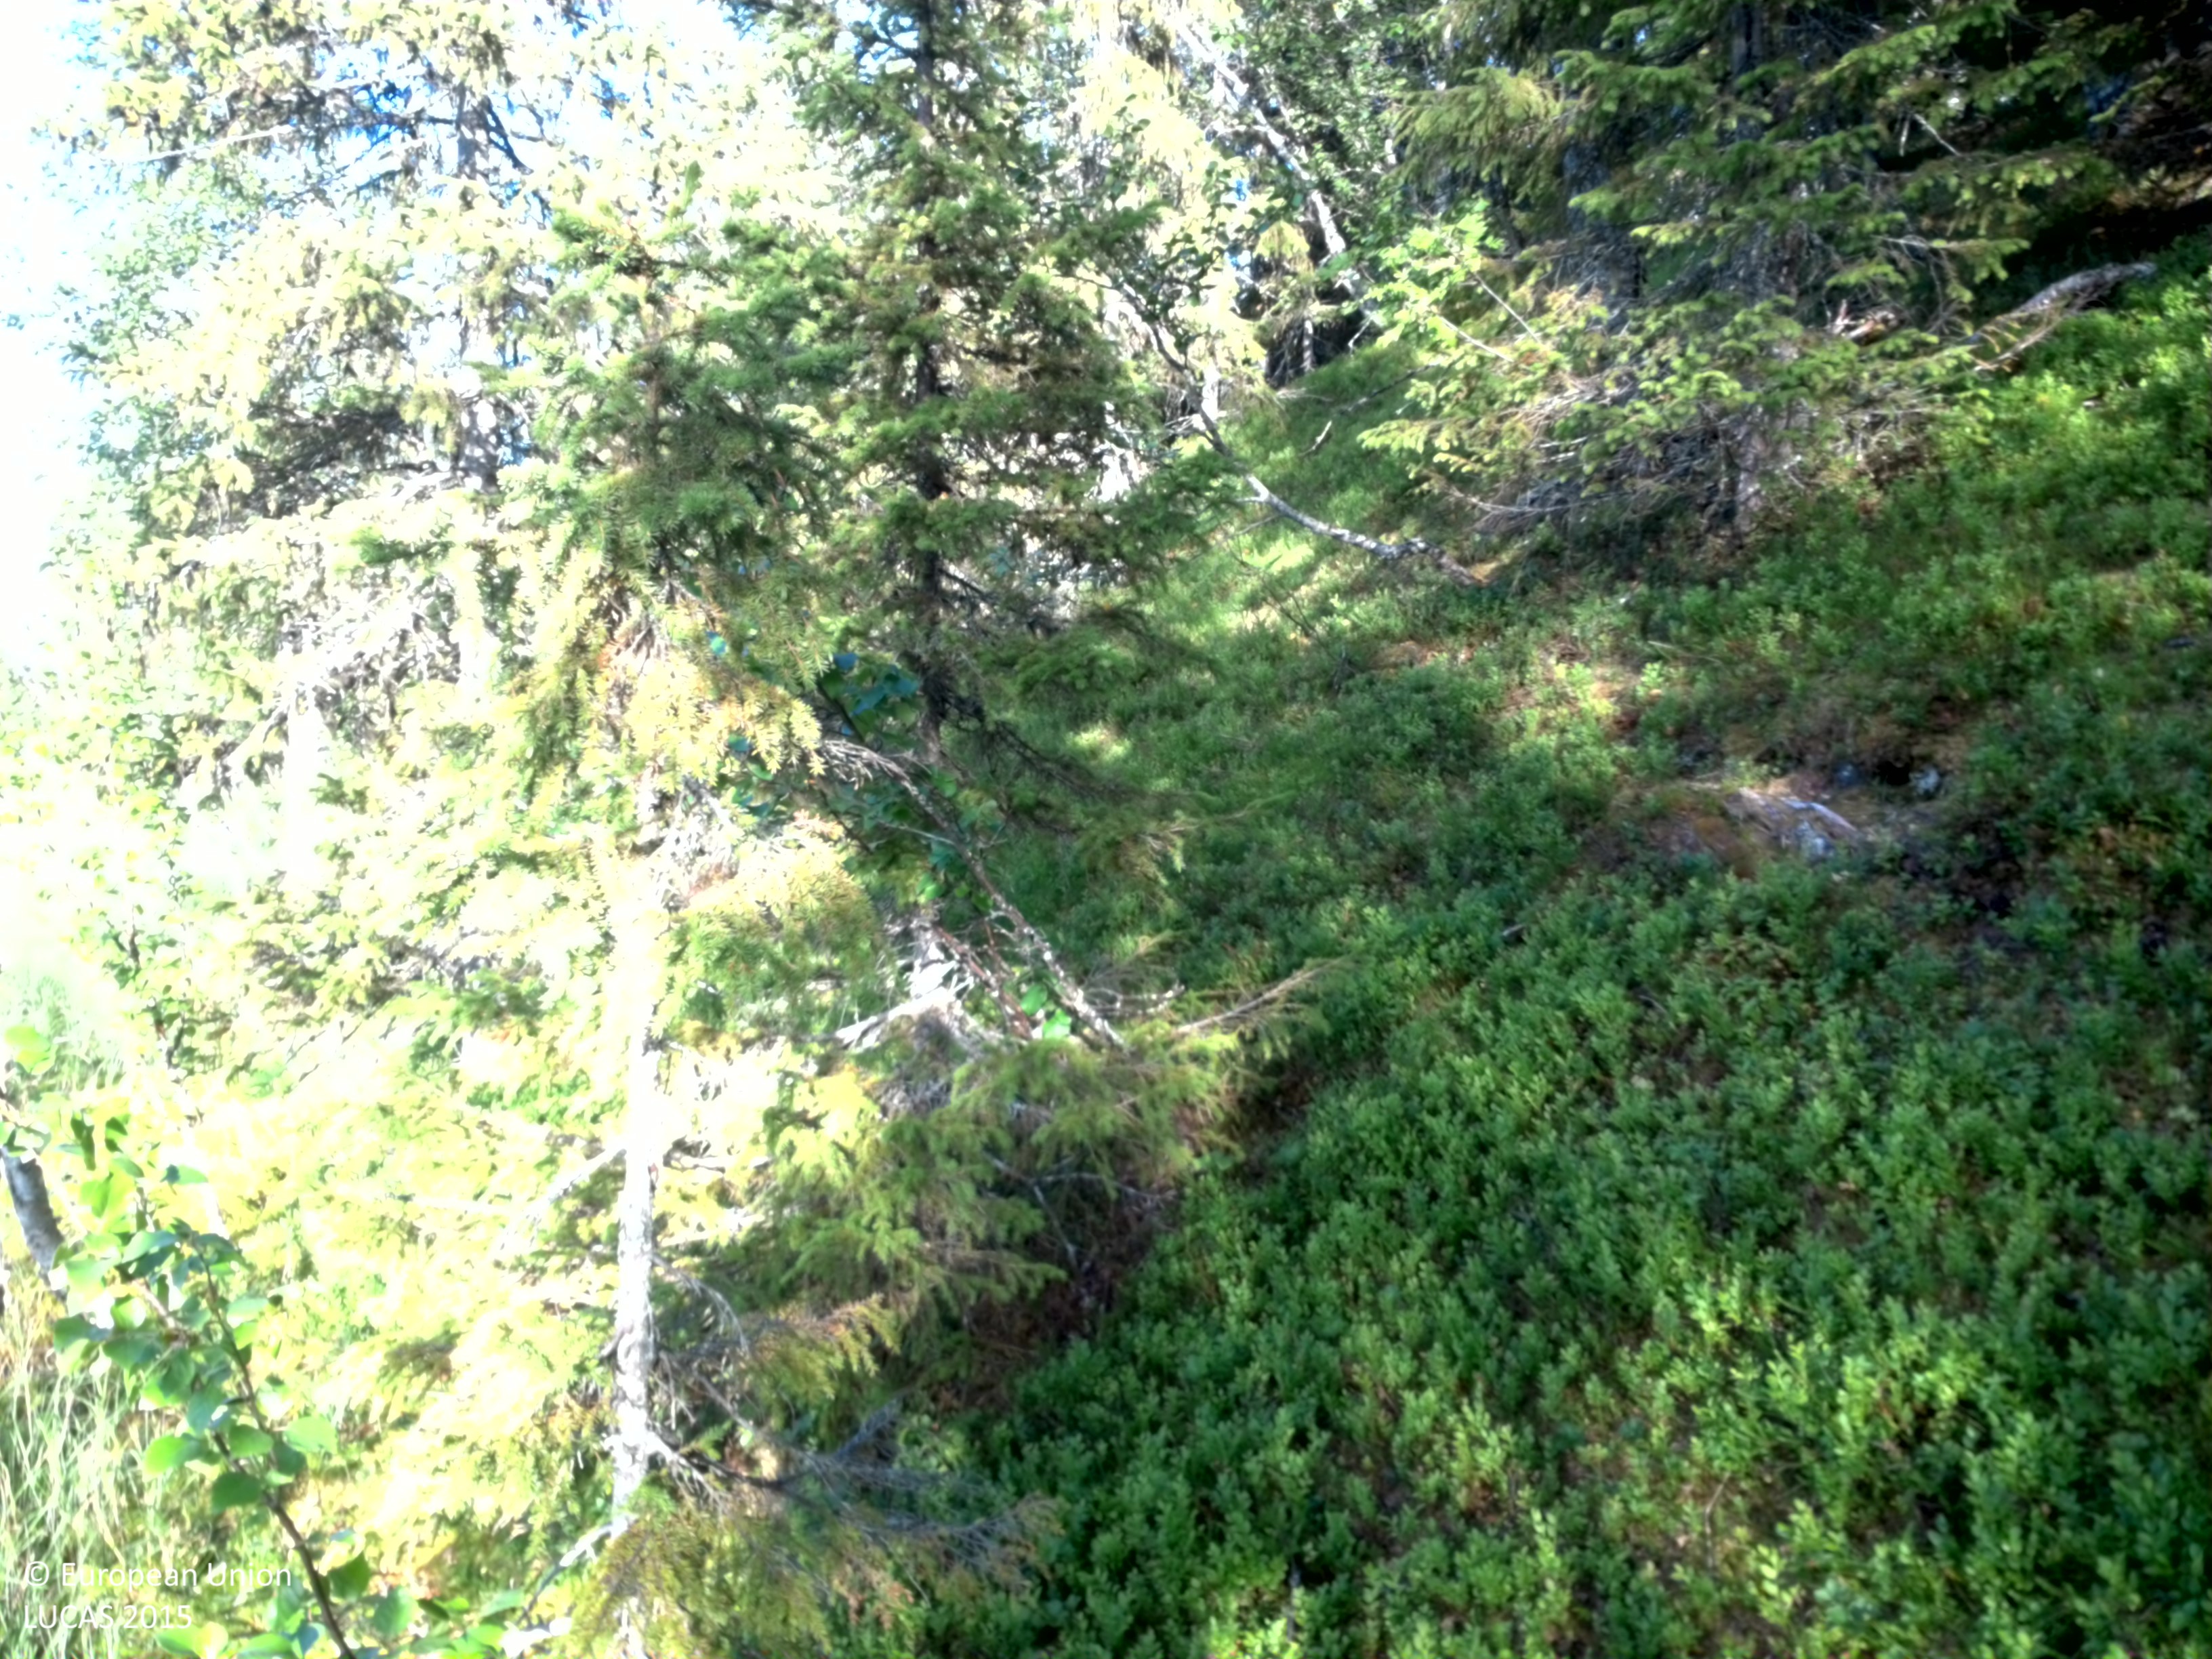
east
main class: Shrubland
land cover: Shrubland with sparse tree cover
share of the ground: 25 - 50 %
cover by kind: herbaceous plants 45 %, lichens and mosses 30 %, shrubs 20 %, broadleaved forest trees 5 %
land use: Semi-natural and natural areas not in use
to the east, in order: Spruce dominated mixed woodland; Shrubland with sparse tree cover; Electric lines; Shrubland with sparse tree cover; Spruce dominated coniferous woodland; Spruce dominated mixed woodland; Rivers and streams; Spruce dominated mixed woodland; Rivers and streams; Spruce dominated mixed woodland
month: August
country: SE
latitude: 64.8995
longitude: 15.5244
